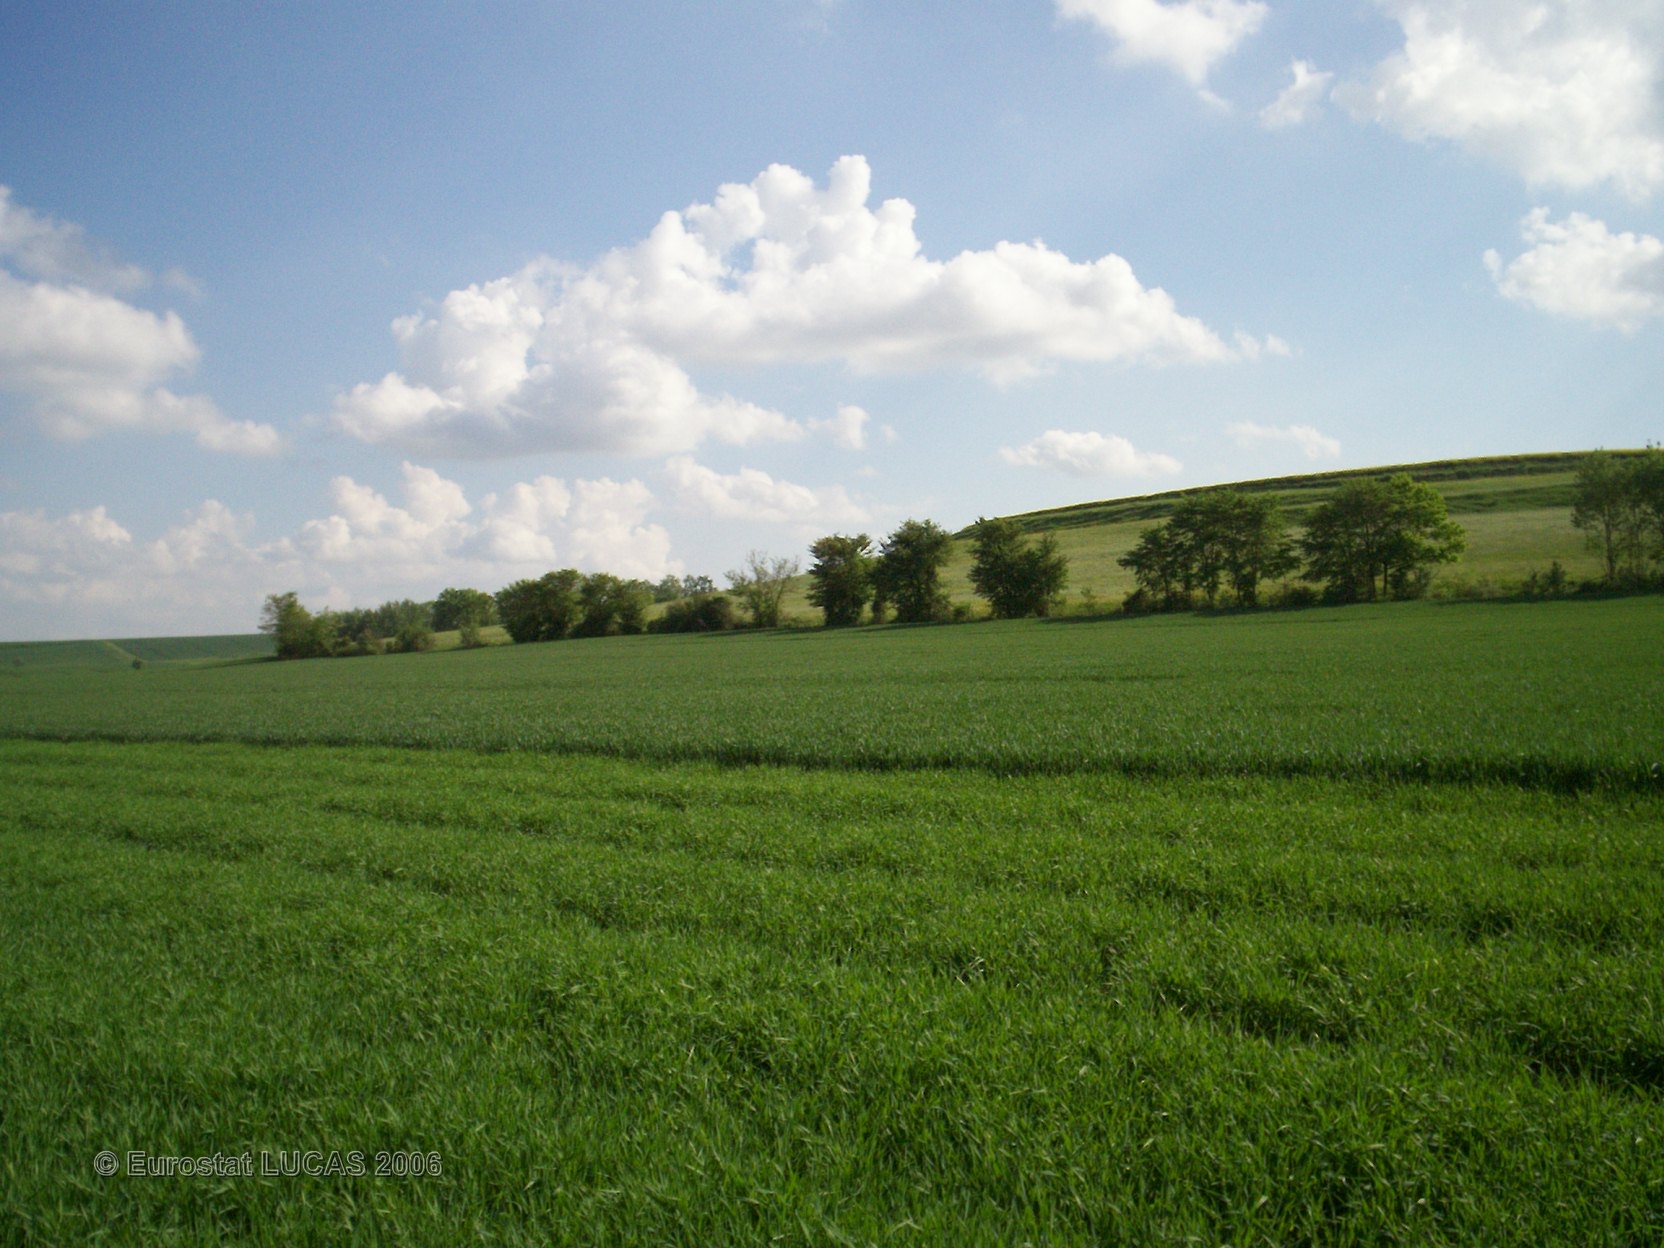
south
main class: Cropland
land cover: Barley
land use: Agriculture (excluding fallow land and kitchen gardens)
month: May
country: FR
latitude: 49.5584
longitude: 4.3693
